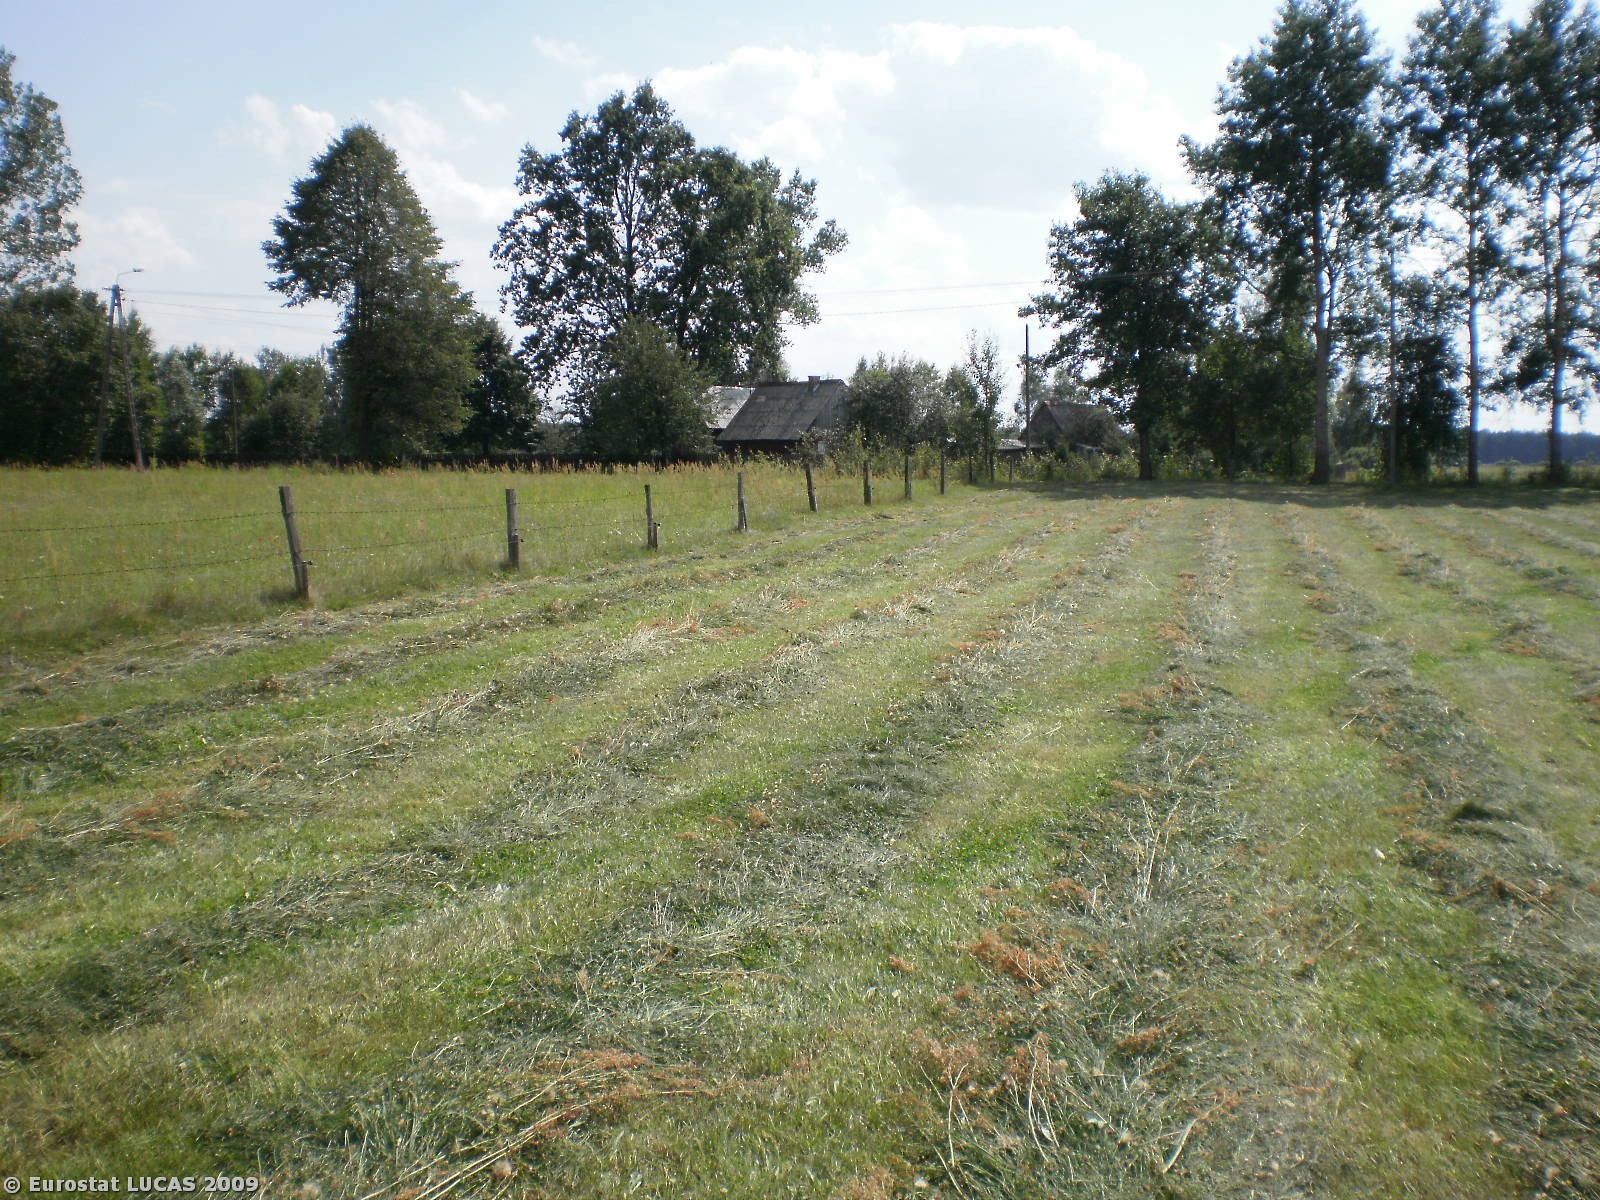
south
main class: Grassland
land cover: Grassland without tree/shrub cover
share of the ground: > 75 %
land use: Agriculture (excluding fallow land and kitchen gardens)
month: July
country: PL
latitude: 53.3967
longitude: 21.3117
